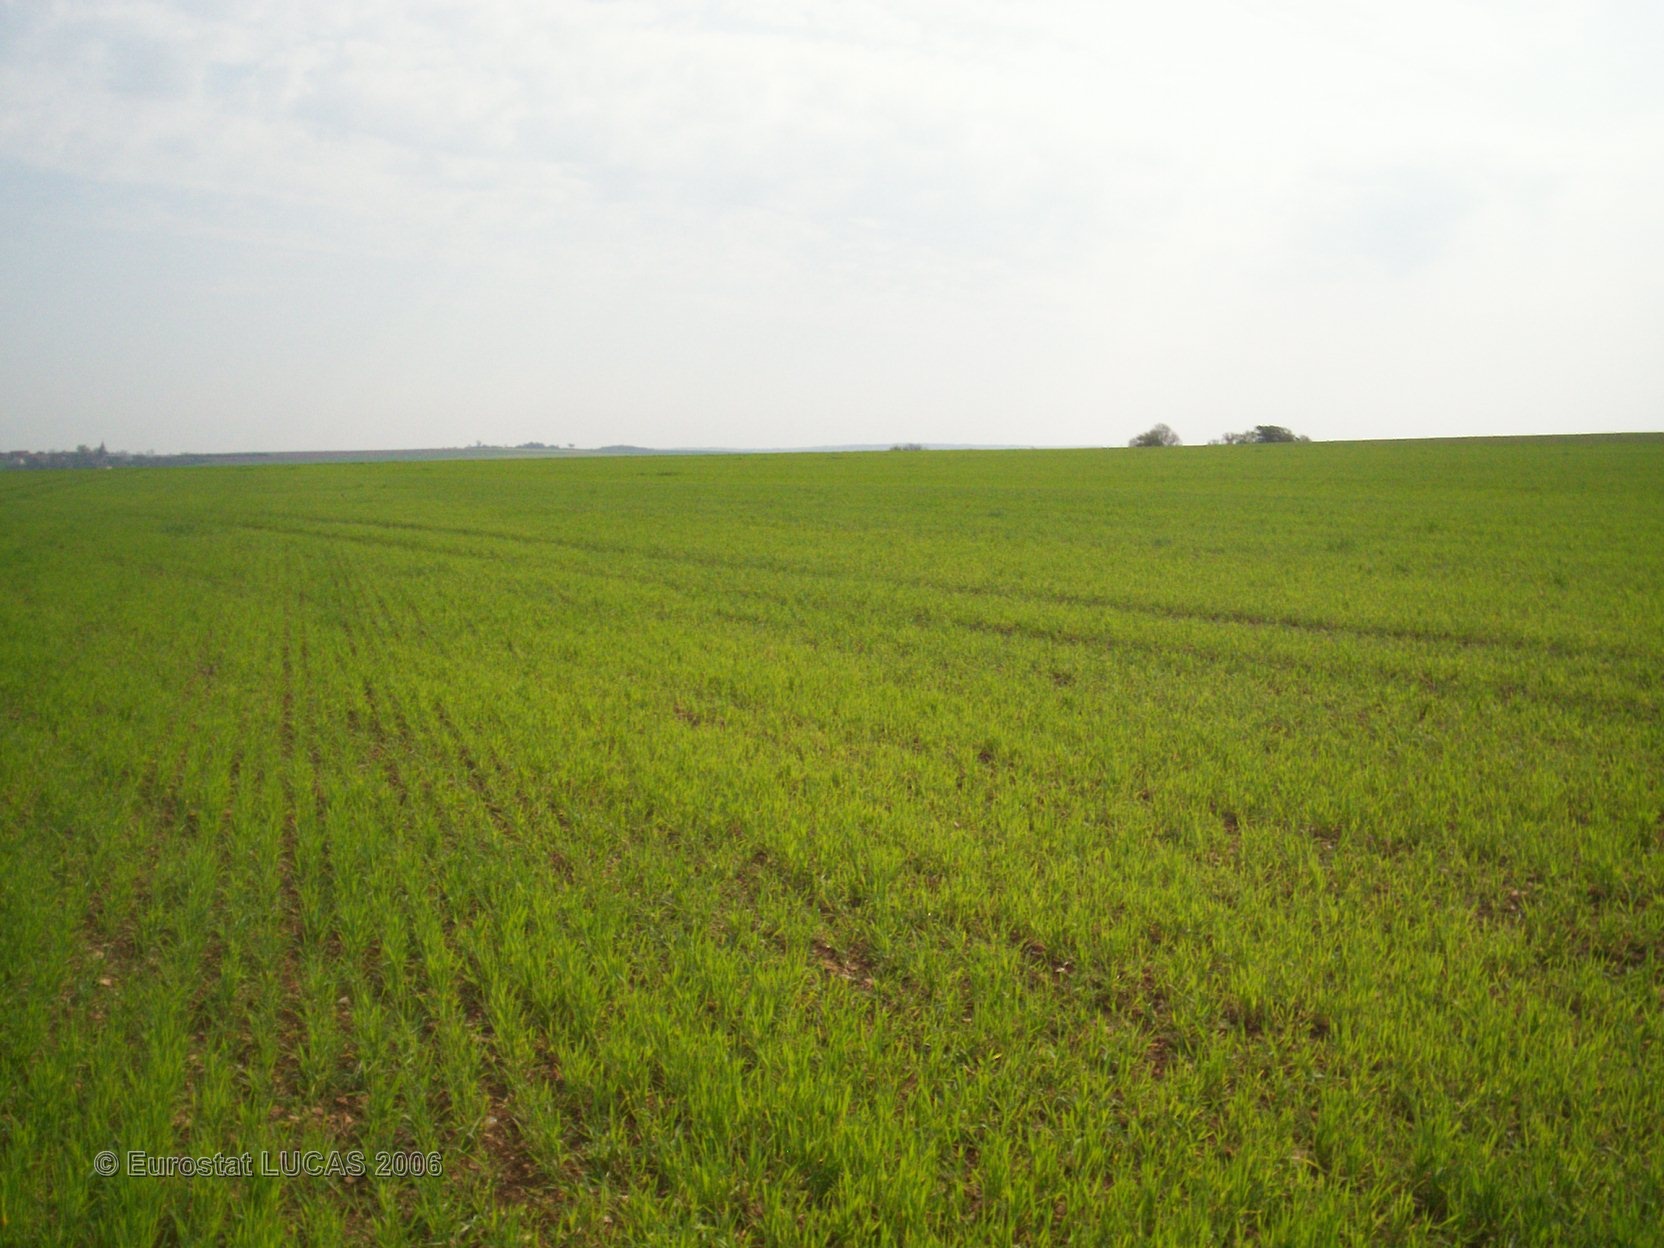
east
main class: Cropland
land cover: Common wheat
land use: Agriculture (excluding fallow land and kitchen gardens)
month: May
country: FR
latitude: 47.5523
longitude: 4.6441
